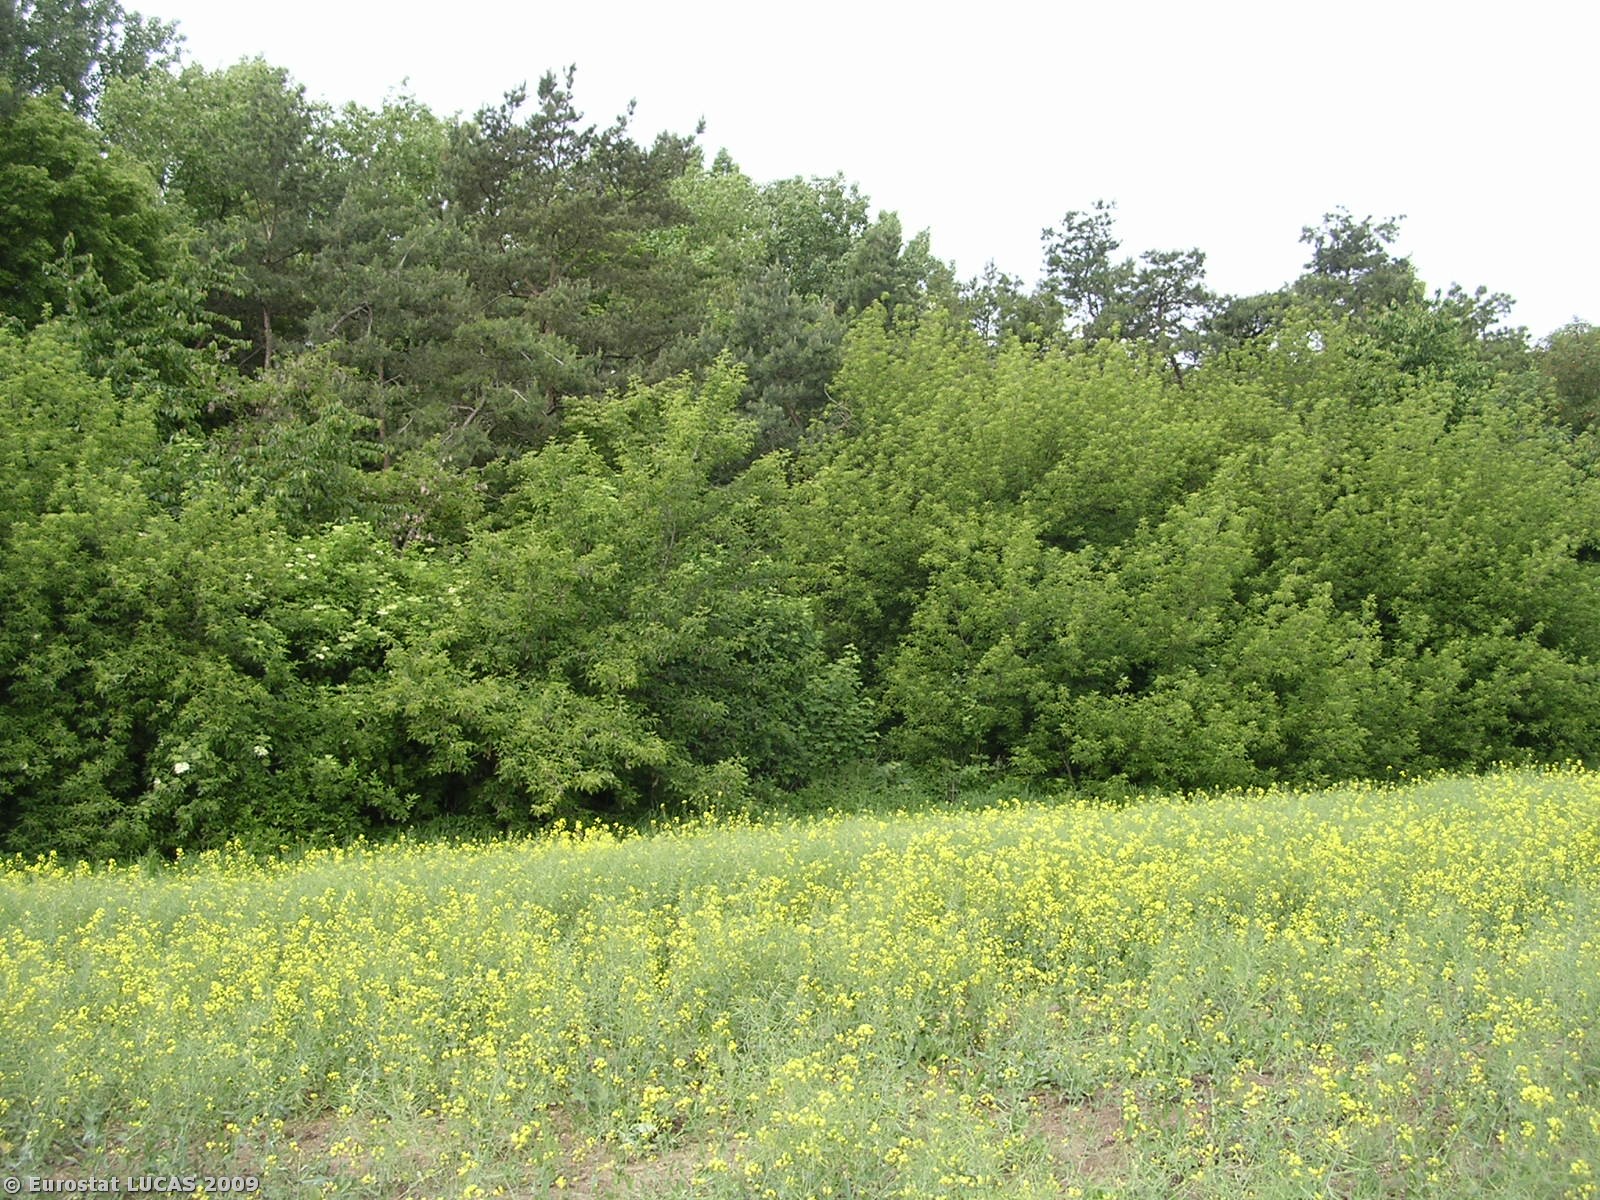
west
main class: Cropland
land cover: Rape and turnip rape
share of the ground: > 75 %
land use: Agriculture (excluding fallow land and kitchen gardens)
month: May
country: CZ
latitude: 50.1598
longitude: 14.6913
